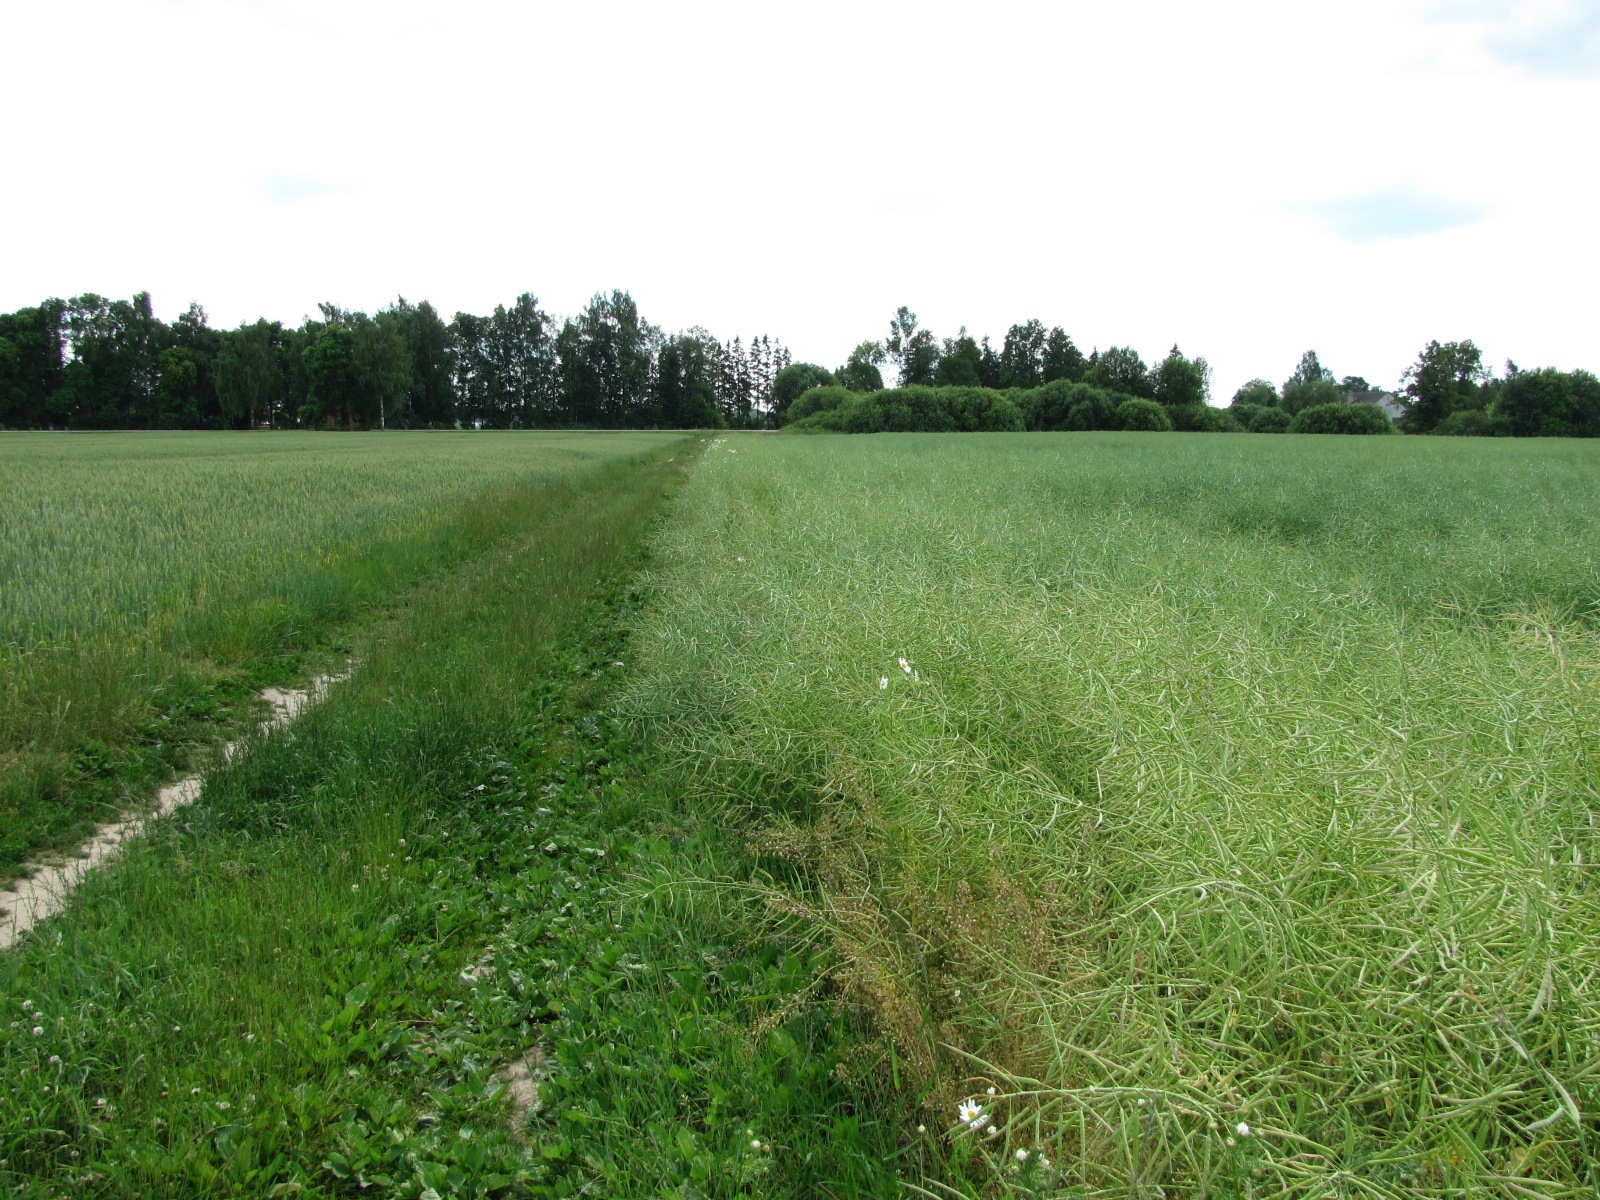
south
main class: Cropland
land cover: Rape and turnip rape
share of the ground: > 75 %
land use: Agriculture (excluding fallow land and kitchen gardens)
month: June
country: LV
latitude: 56.4298
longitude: 23.9154
